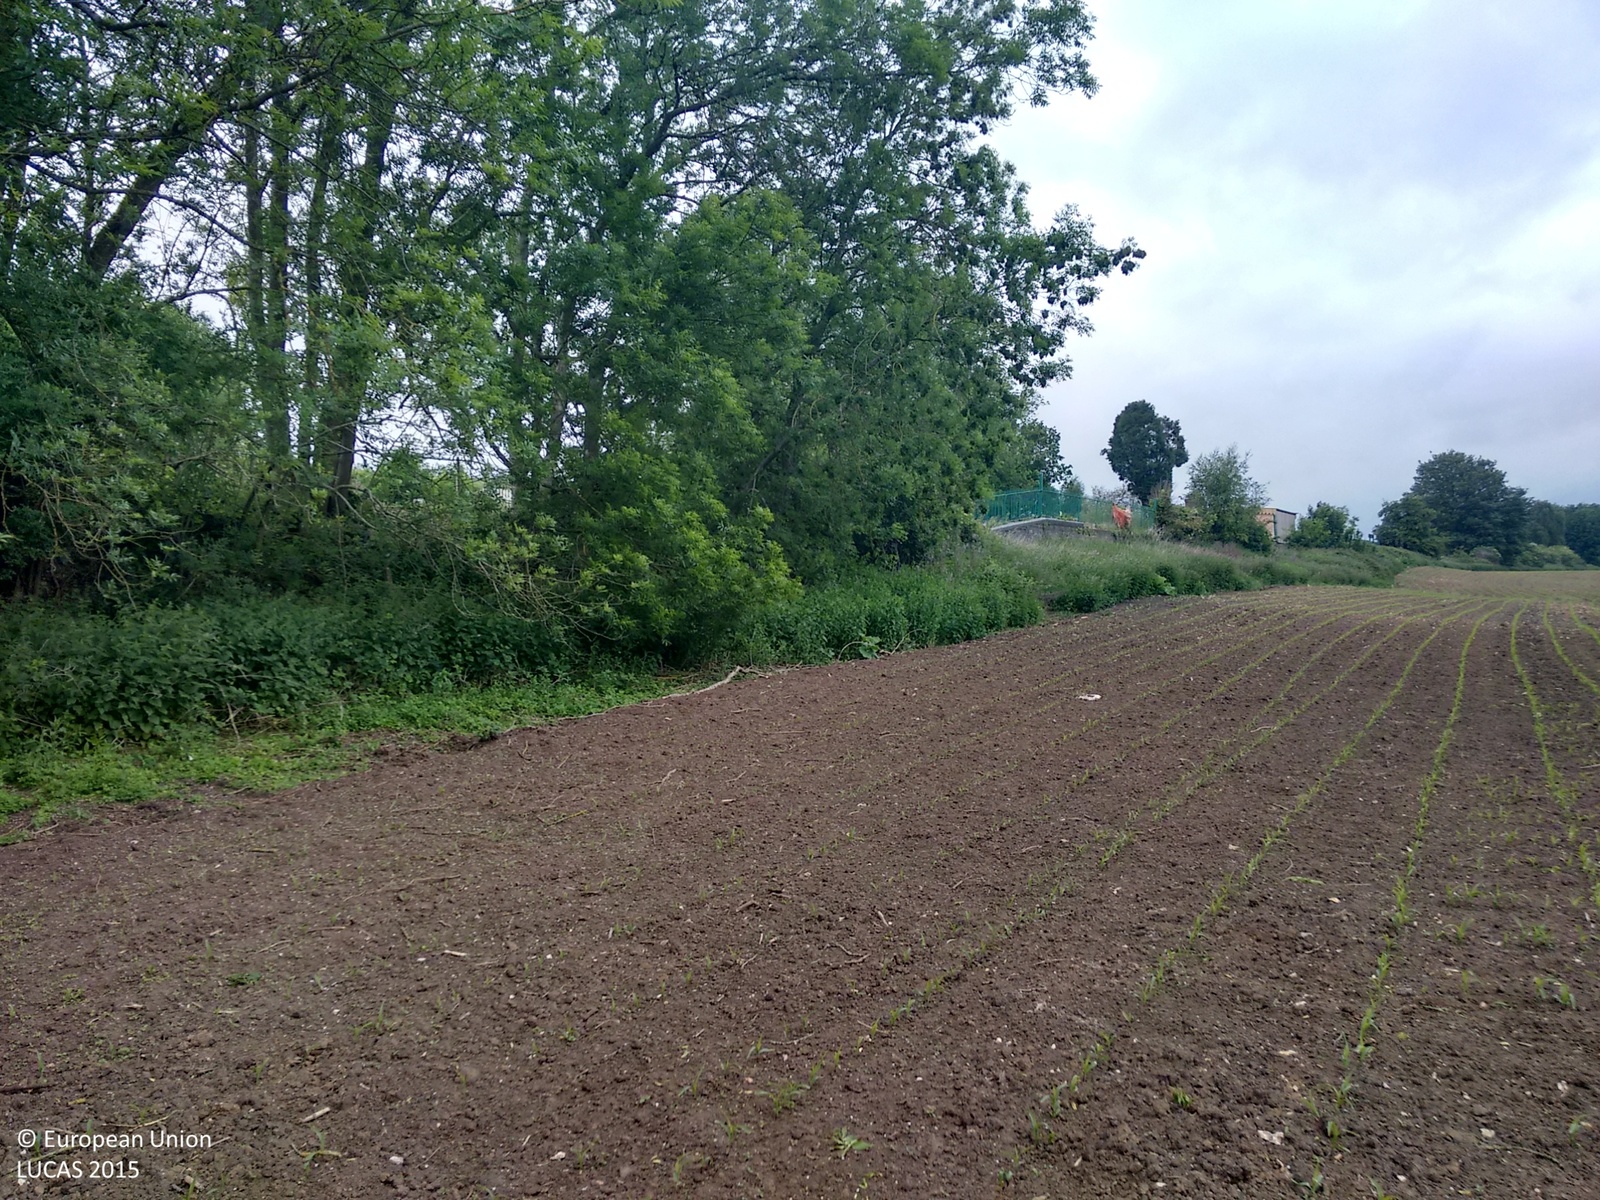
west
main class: Cropland
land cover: Maize
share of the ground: < 10 %
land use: Agriculture (excluding fallow land and kitchen gardens)
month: May
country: GB
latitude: 50.9034
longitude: -2.2488
